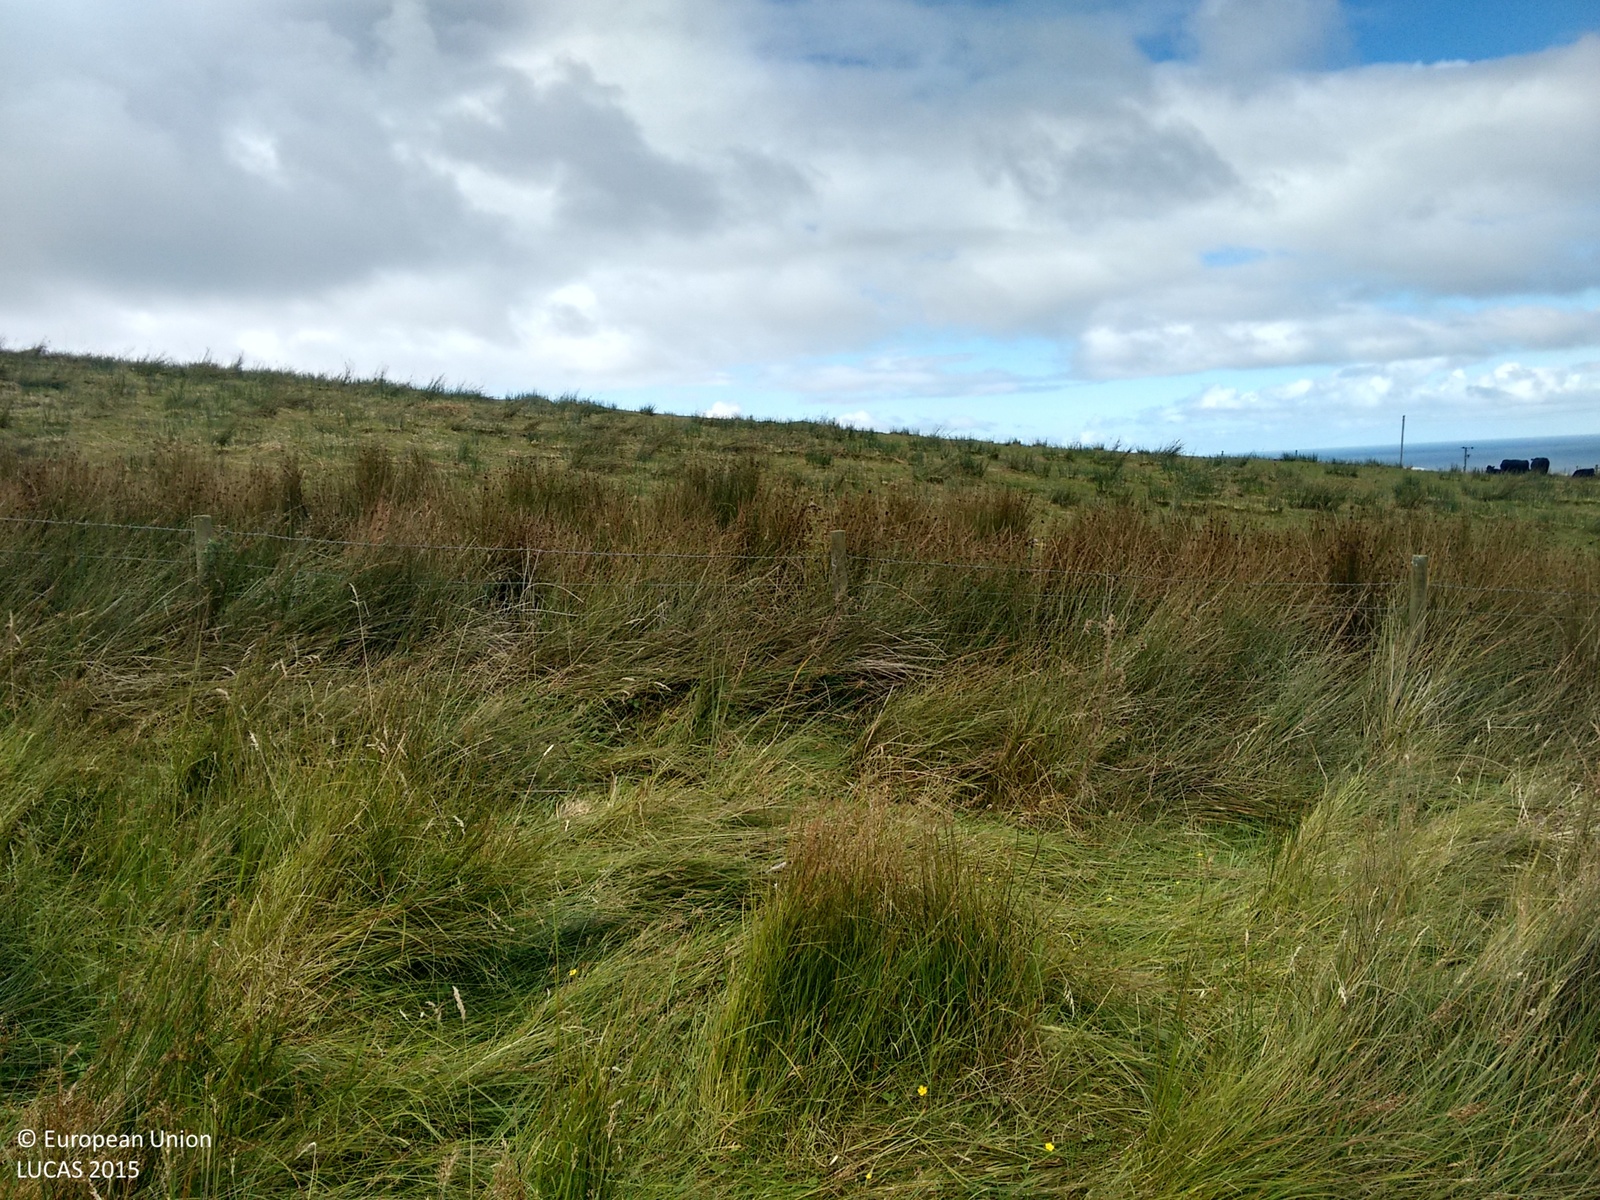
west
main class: Grassland
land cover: Grassland without tree/shrub cover
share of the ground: > 75 %
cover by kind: herbaceous plants 100 %
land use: Agriculture (excluding fallow land and kitchen gardens)
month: September
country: GB
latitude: 55.4077
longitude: -5.7514
